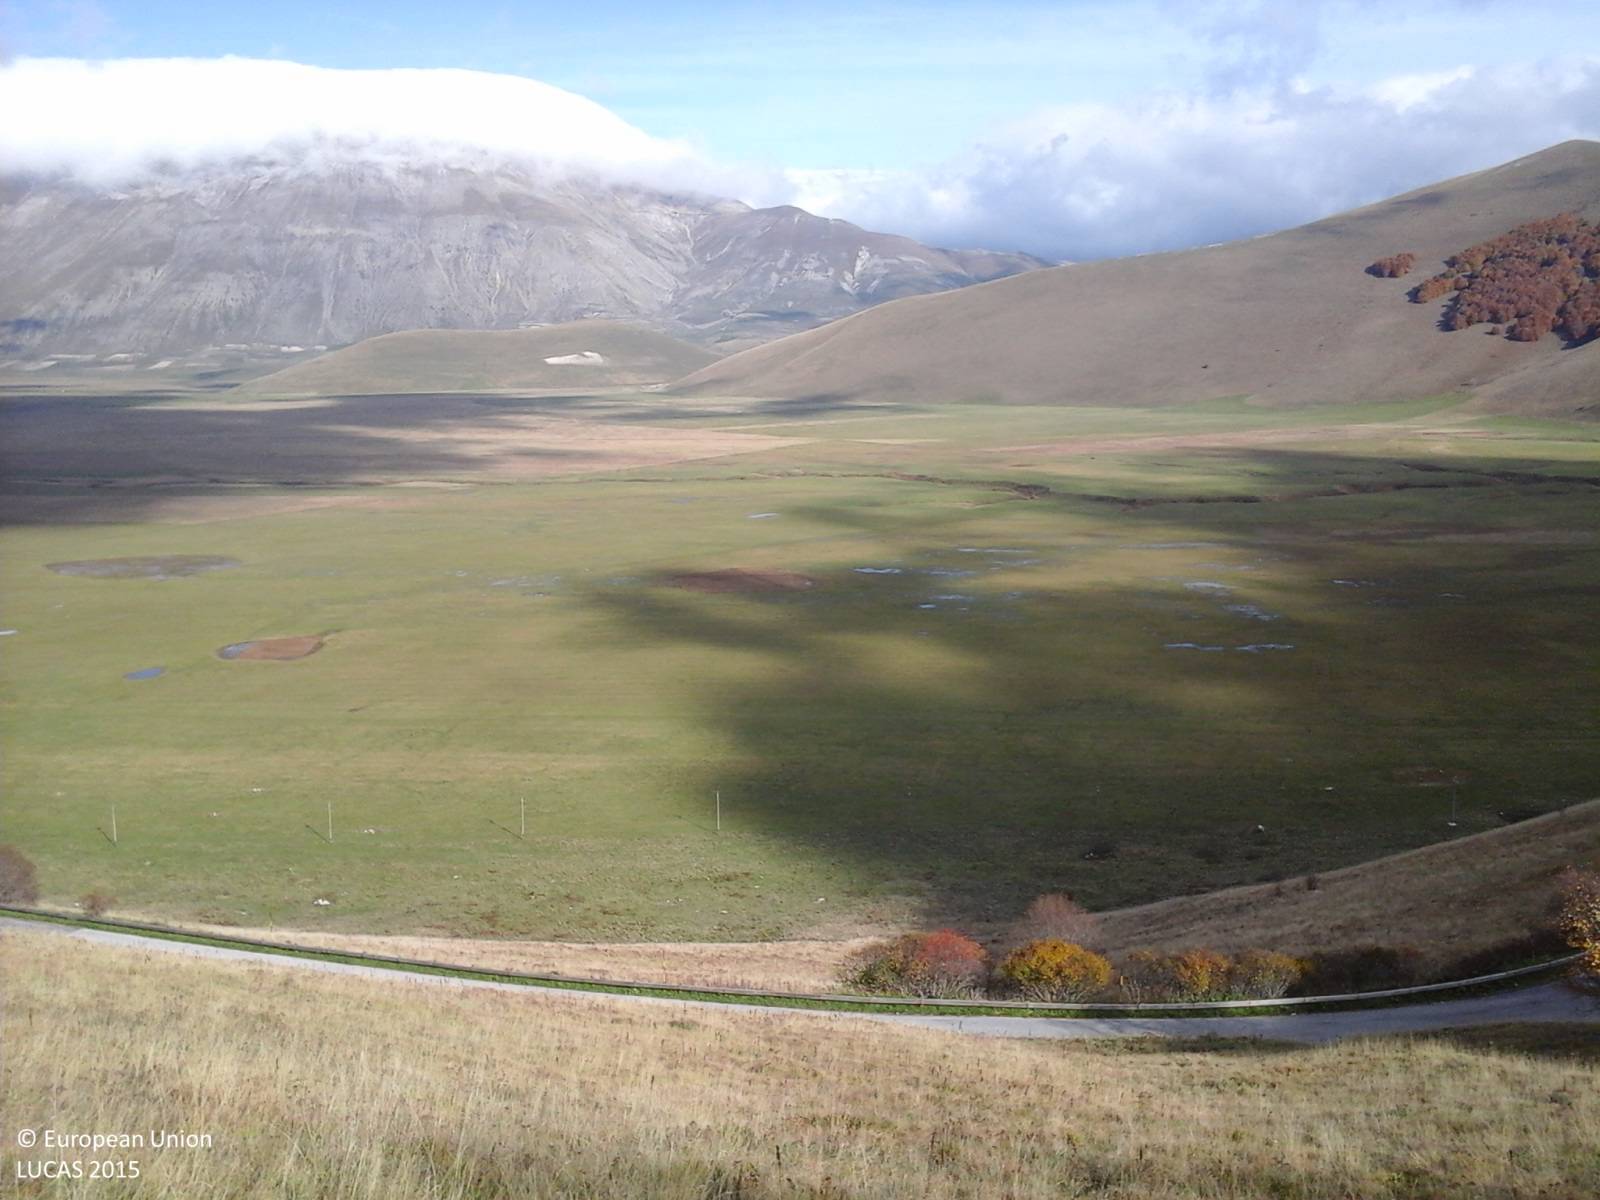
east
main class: Grassland
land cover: Grassland without tree/shrub cover
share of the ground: > 75 %
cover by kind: herbaceous plants 100 %
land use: Agriculture (excluding fallow land and kitchen gardens)
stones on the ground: < 10 %
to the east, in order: Grassland without tree/shrub cover; Paved roads, cycling and walking lanes; Fences; Abandoned hedges; Grassland without tree/shrub cover
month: October
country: IT
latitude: 42.7848
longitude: 13.1811
